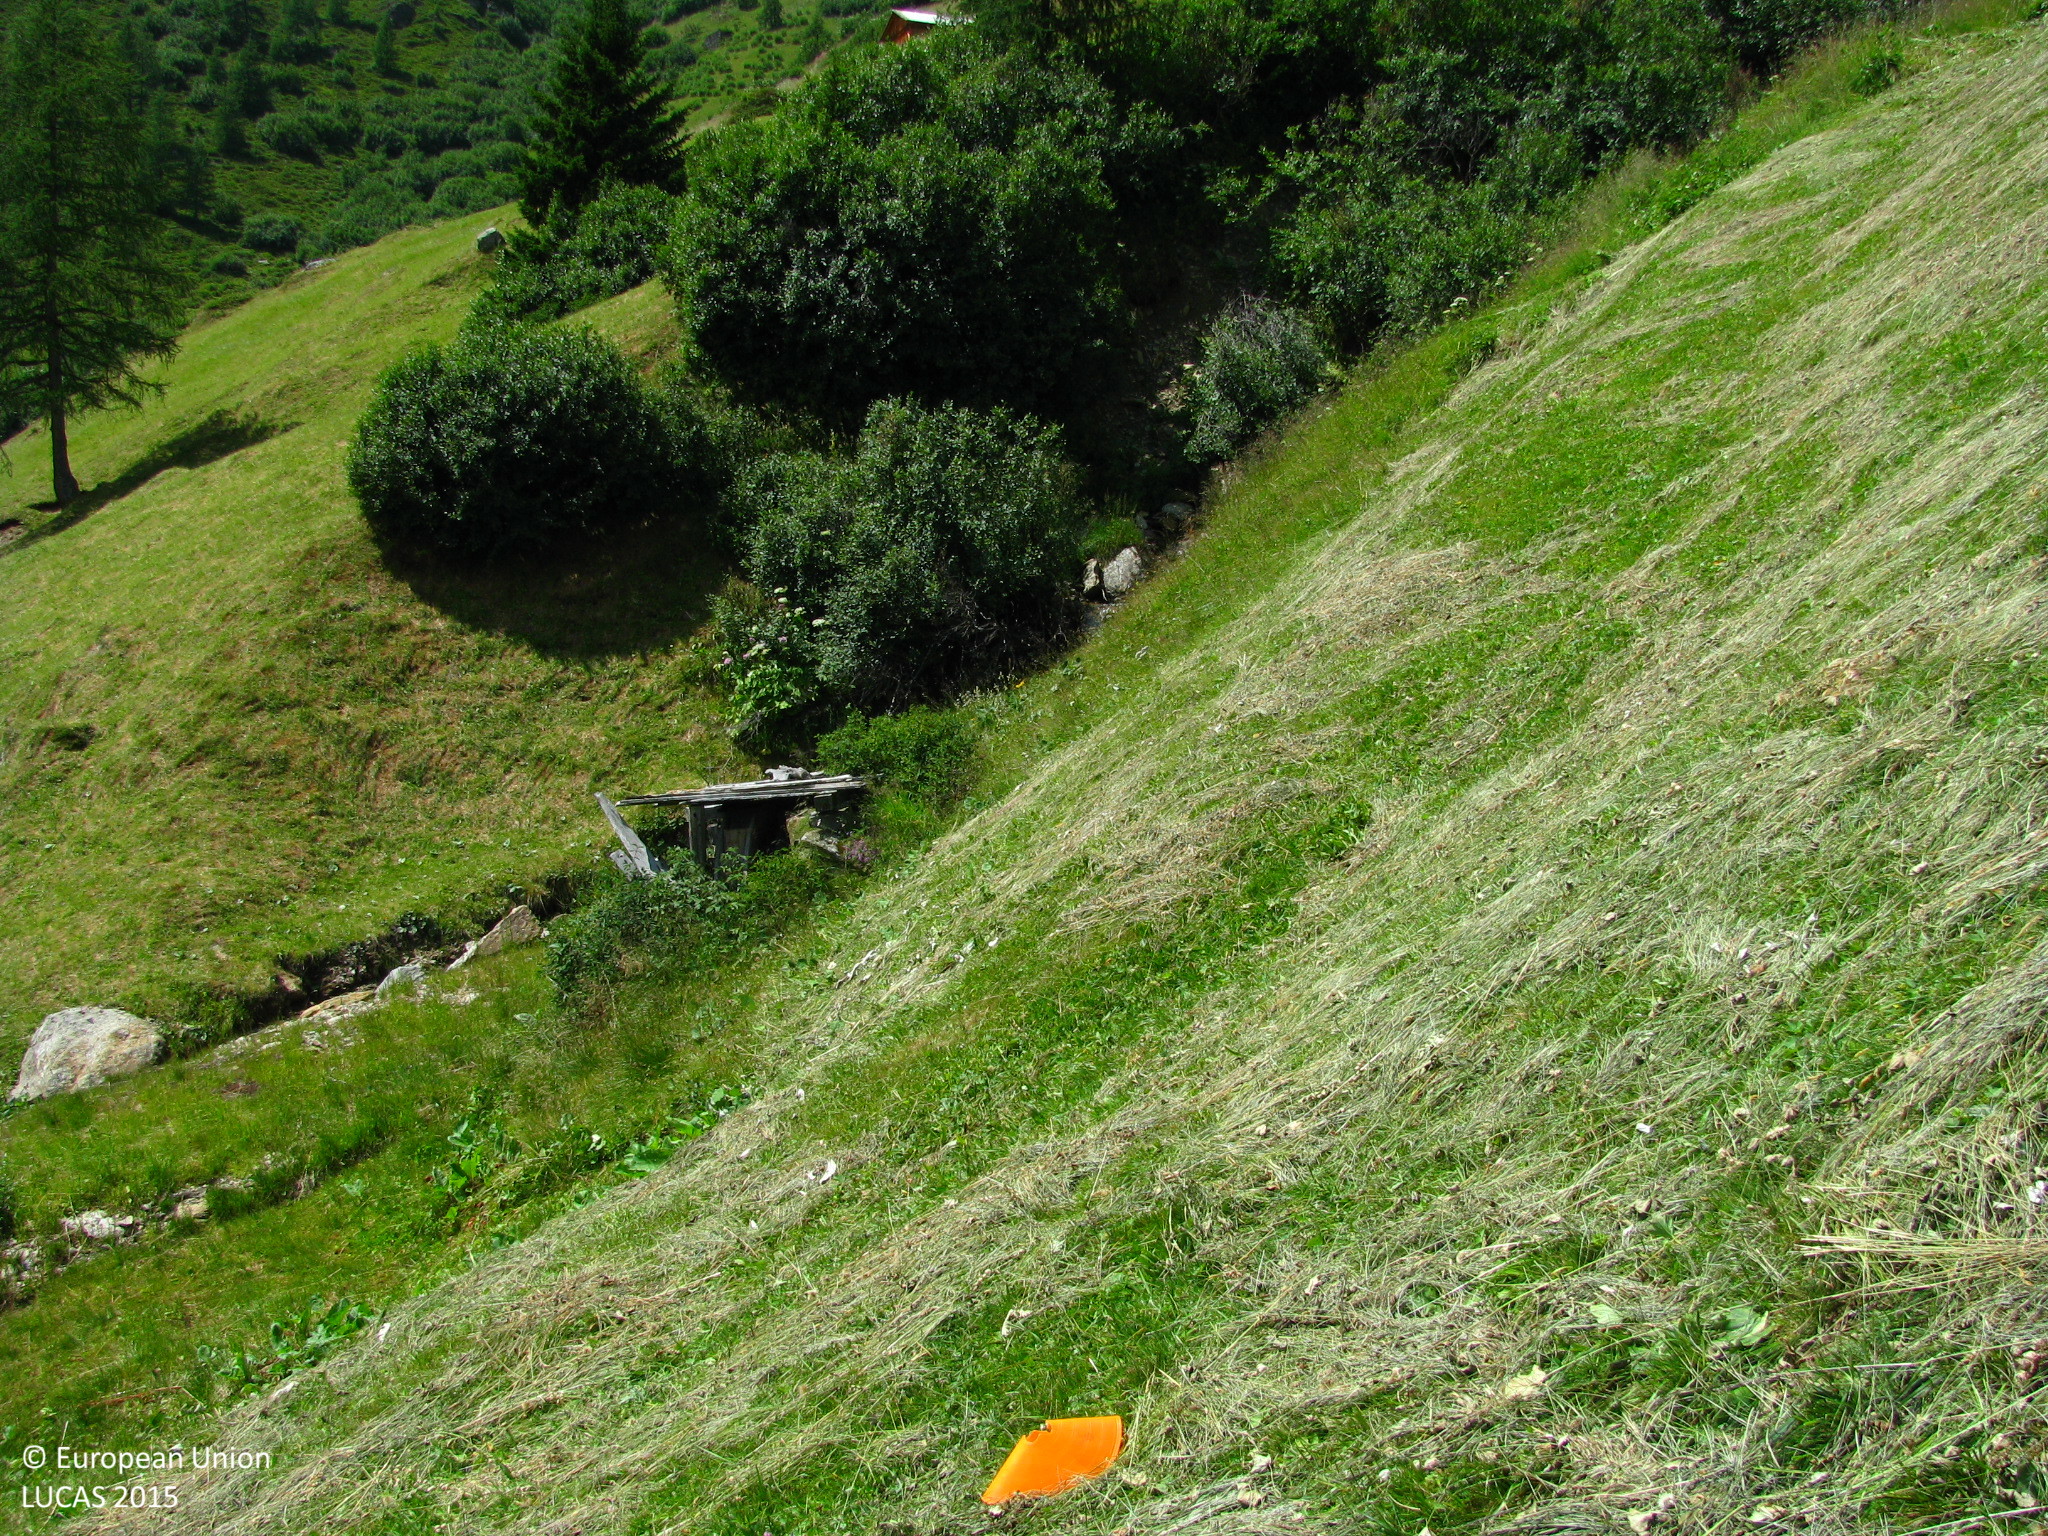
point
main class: Grassland
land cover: Grassland without tree/shrub cover
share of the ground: > 75 %
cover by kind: herbaceous plants 95 %, shrubs 5 %
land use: Agriculture (excluding fallow land and kitchen gardens)
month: July
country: AT
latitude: 46.8277
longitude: 12.4491
